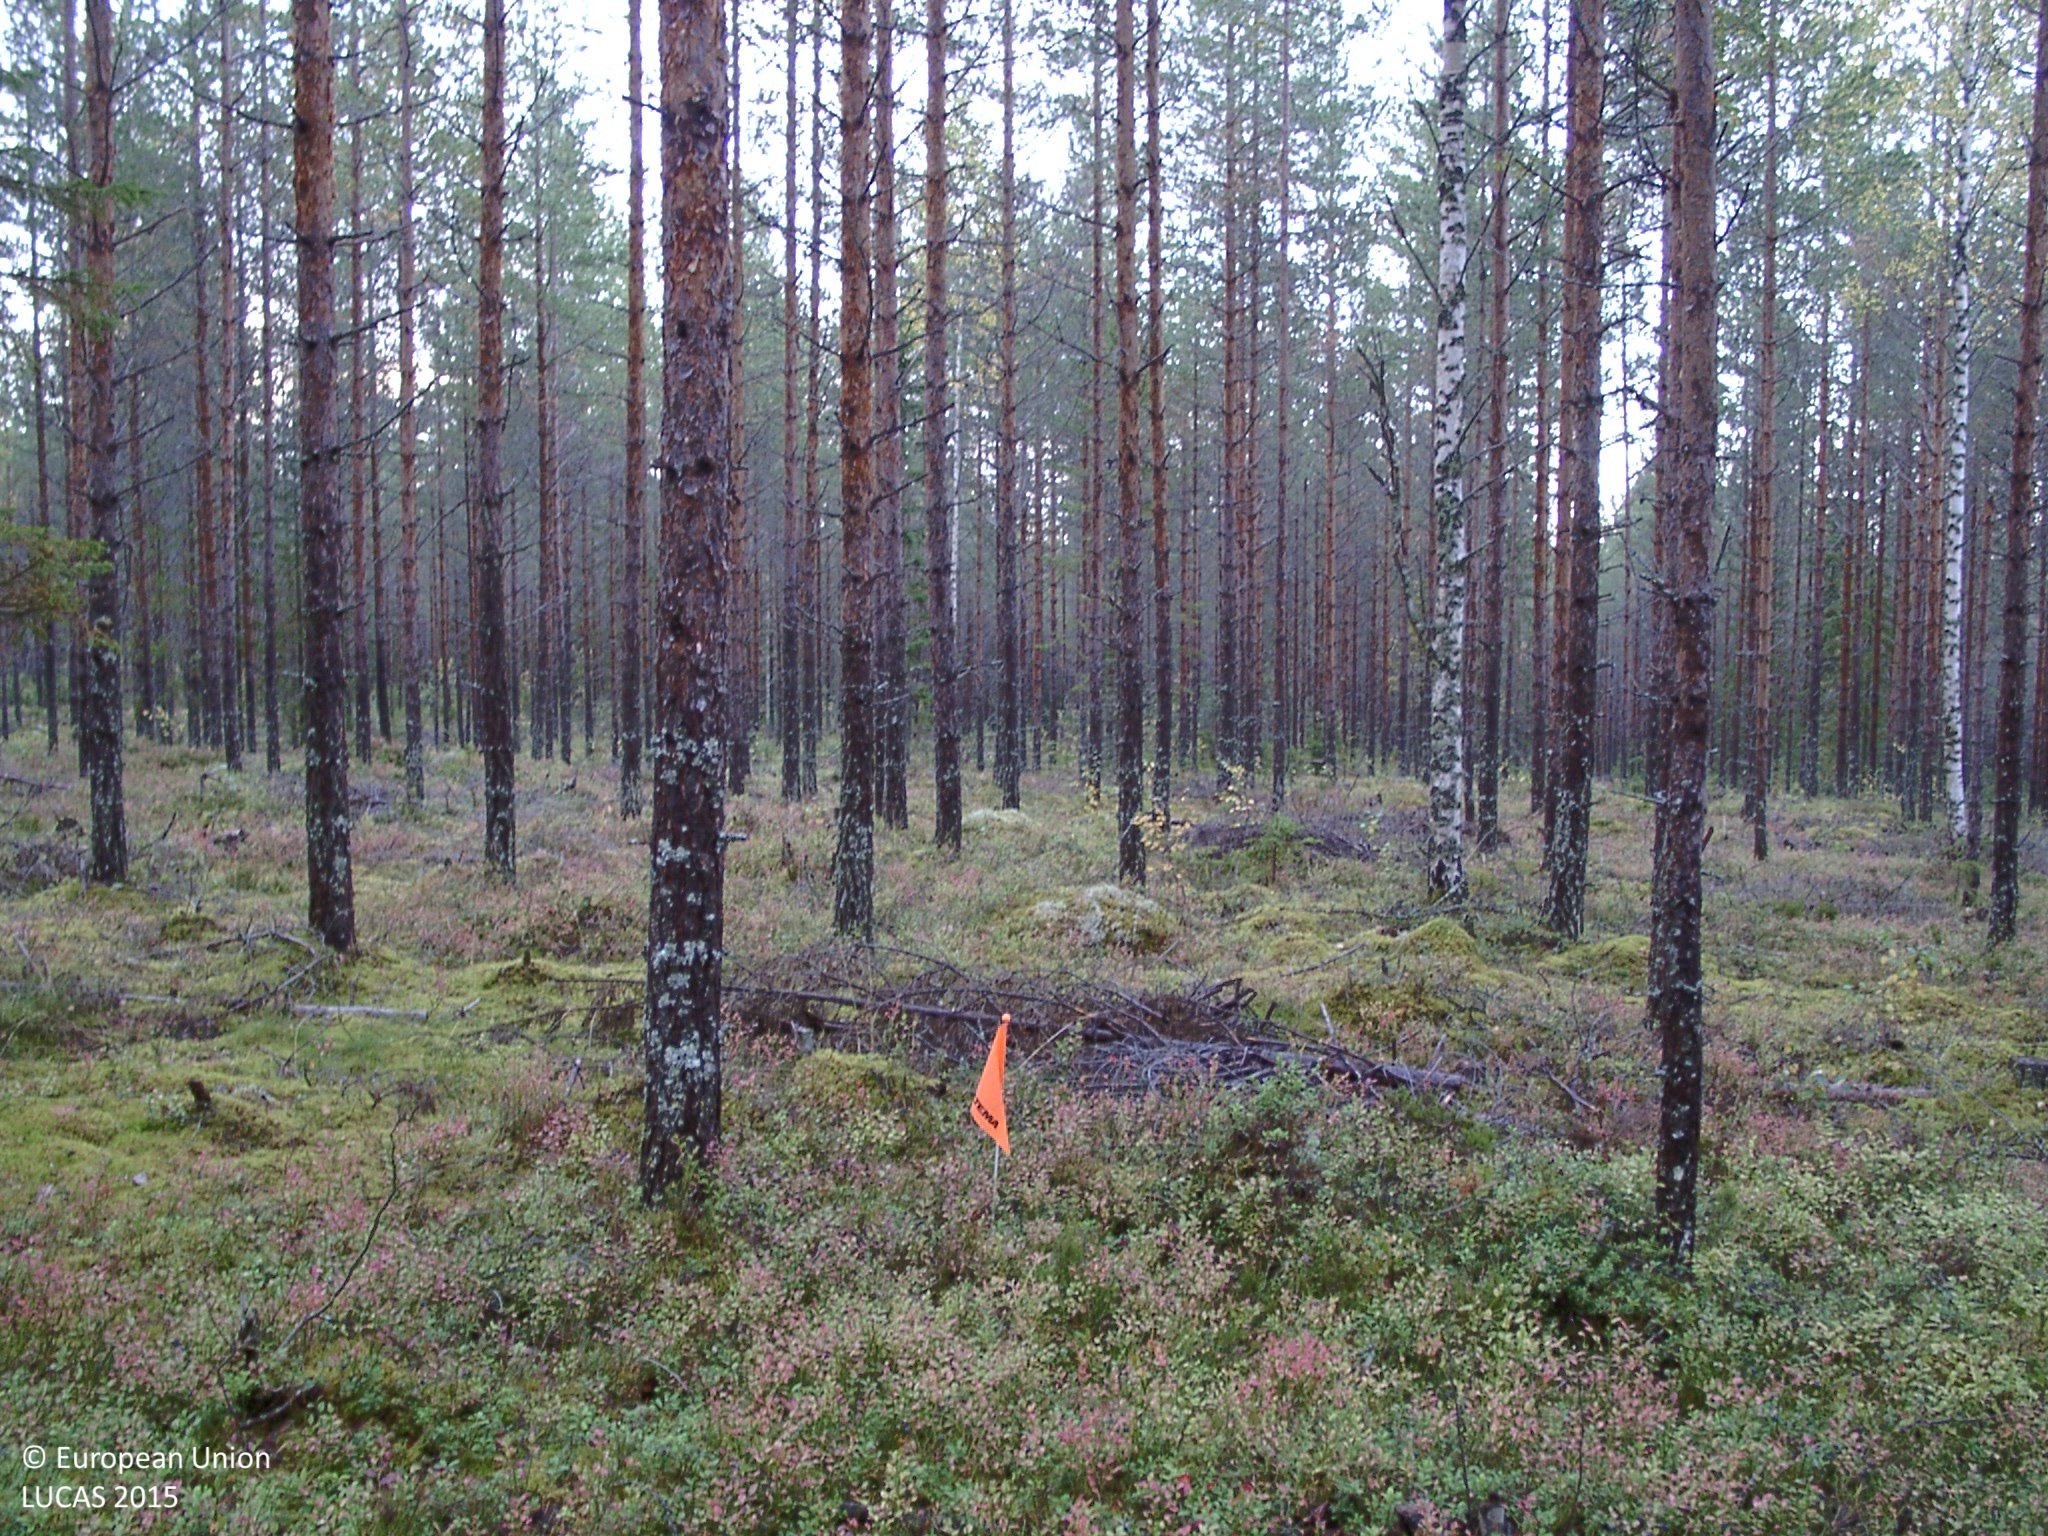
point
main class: Woodland
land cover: Pine dominated coniferous woodland
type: boreal forest
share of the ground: 50 - 75 %
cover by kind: coniferous forest trees 65 %, lichens and mosses 20 %, shrubs 15 %
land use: Forestry
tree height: > 5 m
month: September
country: FI
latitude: 62.7380
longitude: 25.5502
